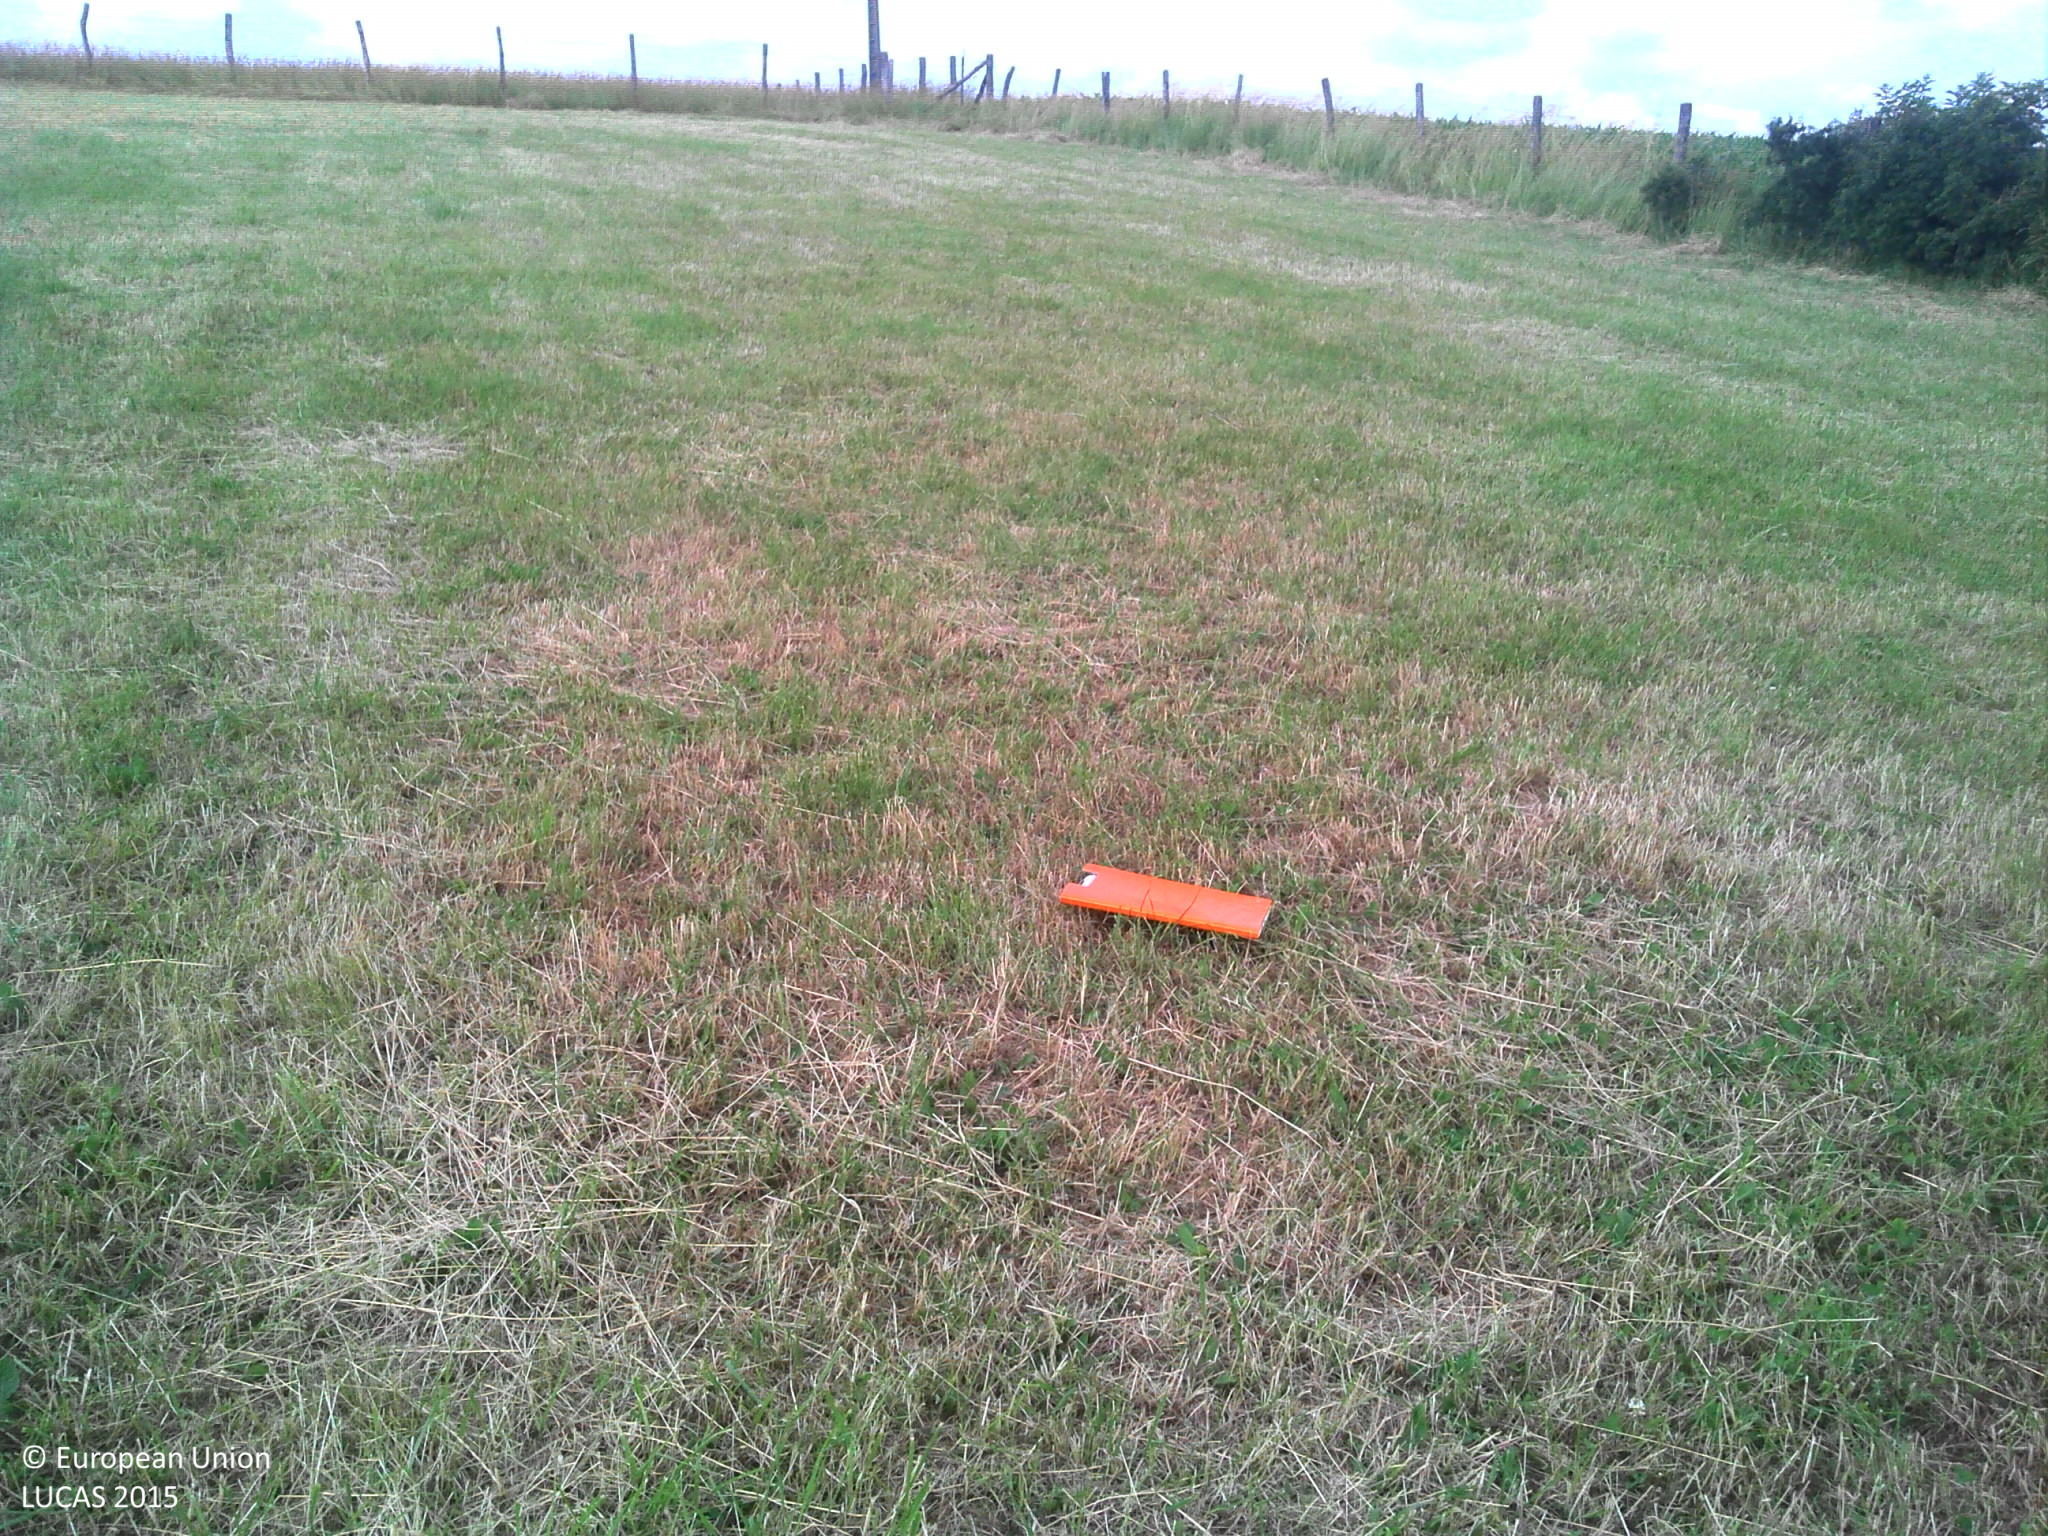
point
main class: Grassland
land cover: Grassland without tree/shrub cover
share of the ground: > 75 %
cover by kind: herbaceous plants 100 %
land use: Agriculture (excluding fallow land and kitchen gardens)
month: June
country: FR
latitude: 48.2687
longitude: 4.9194
